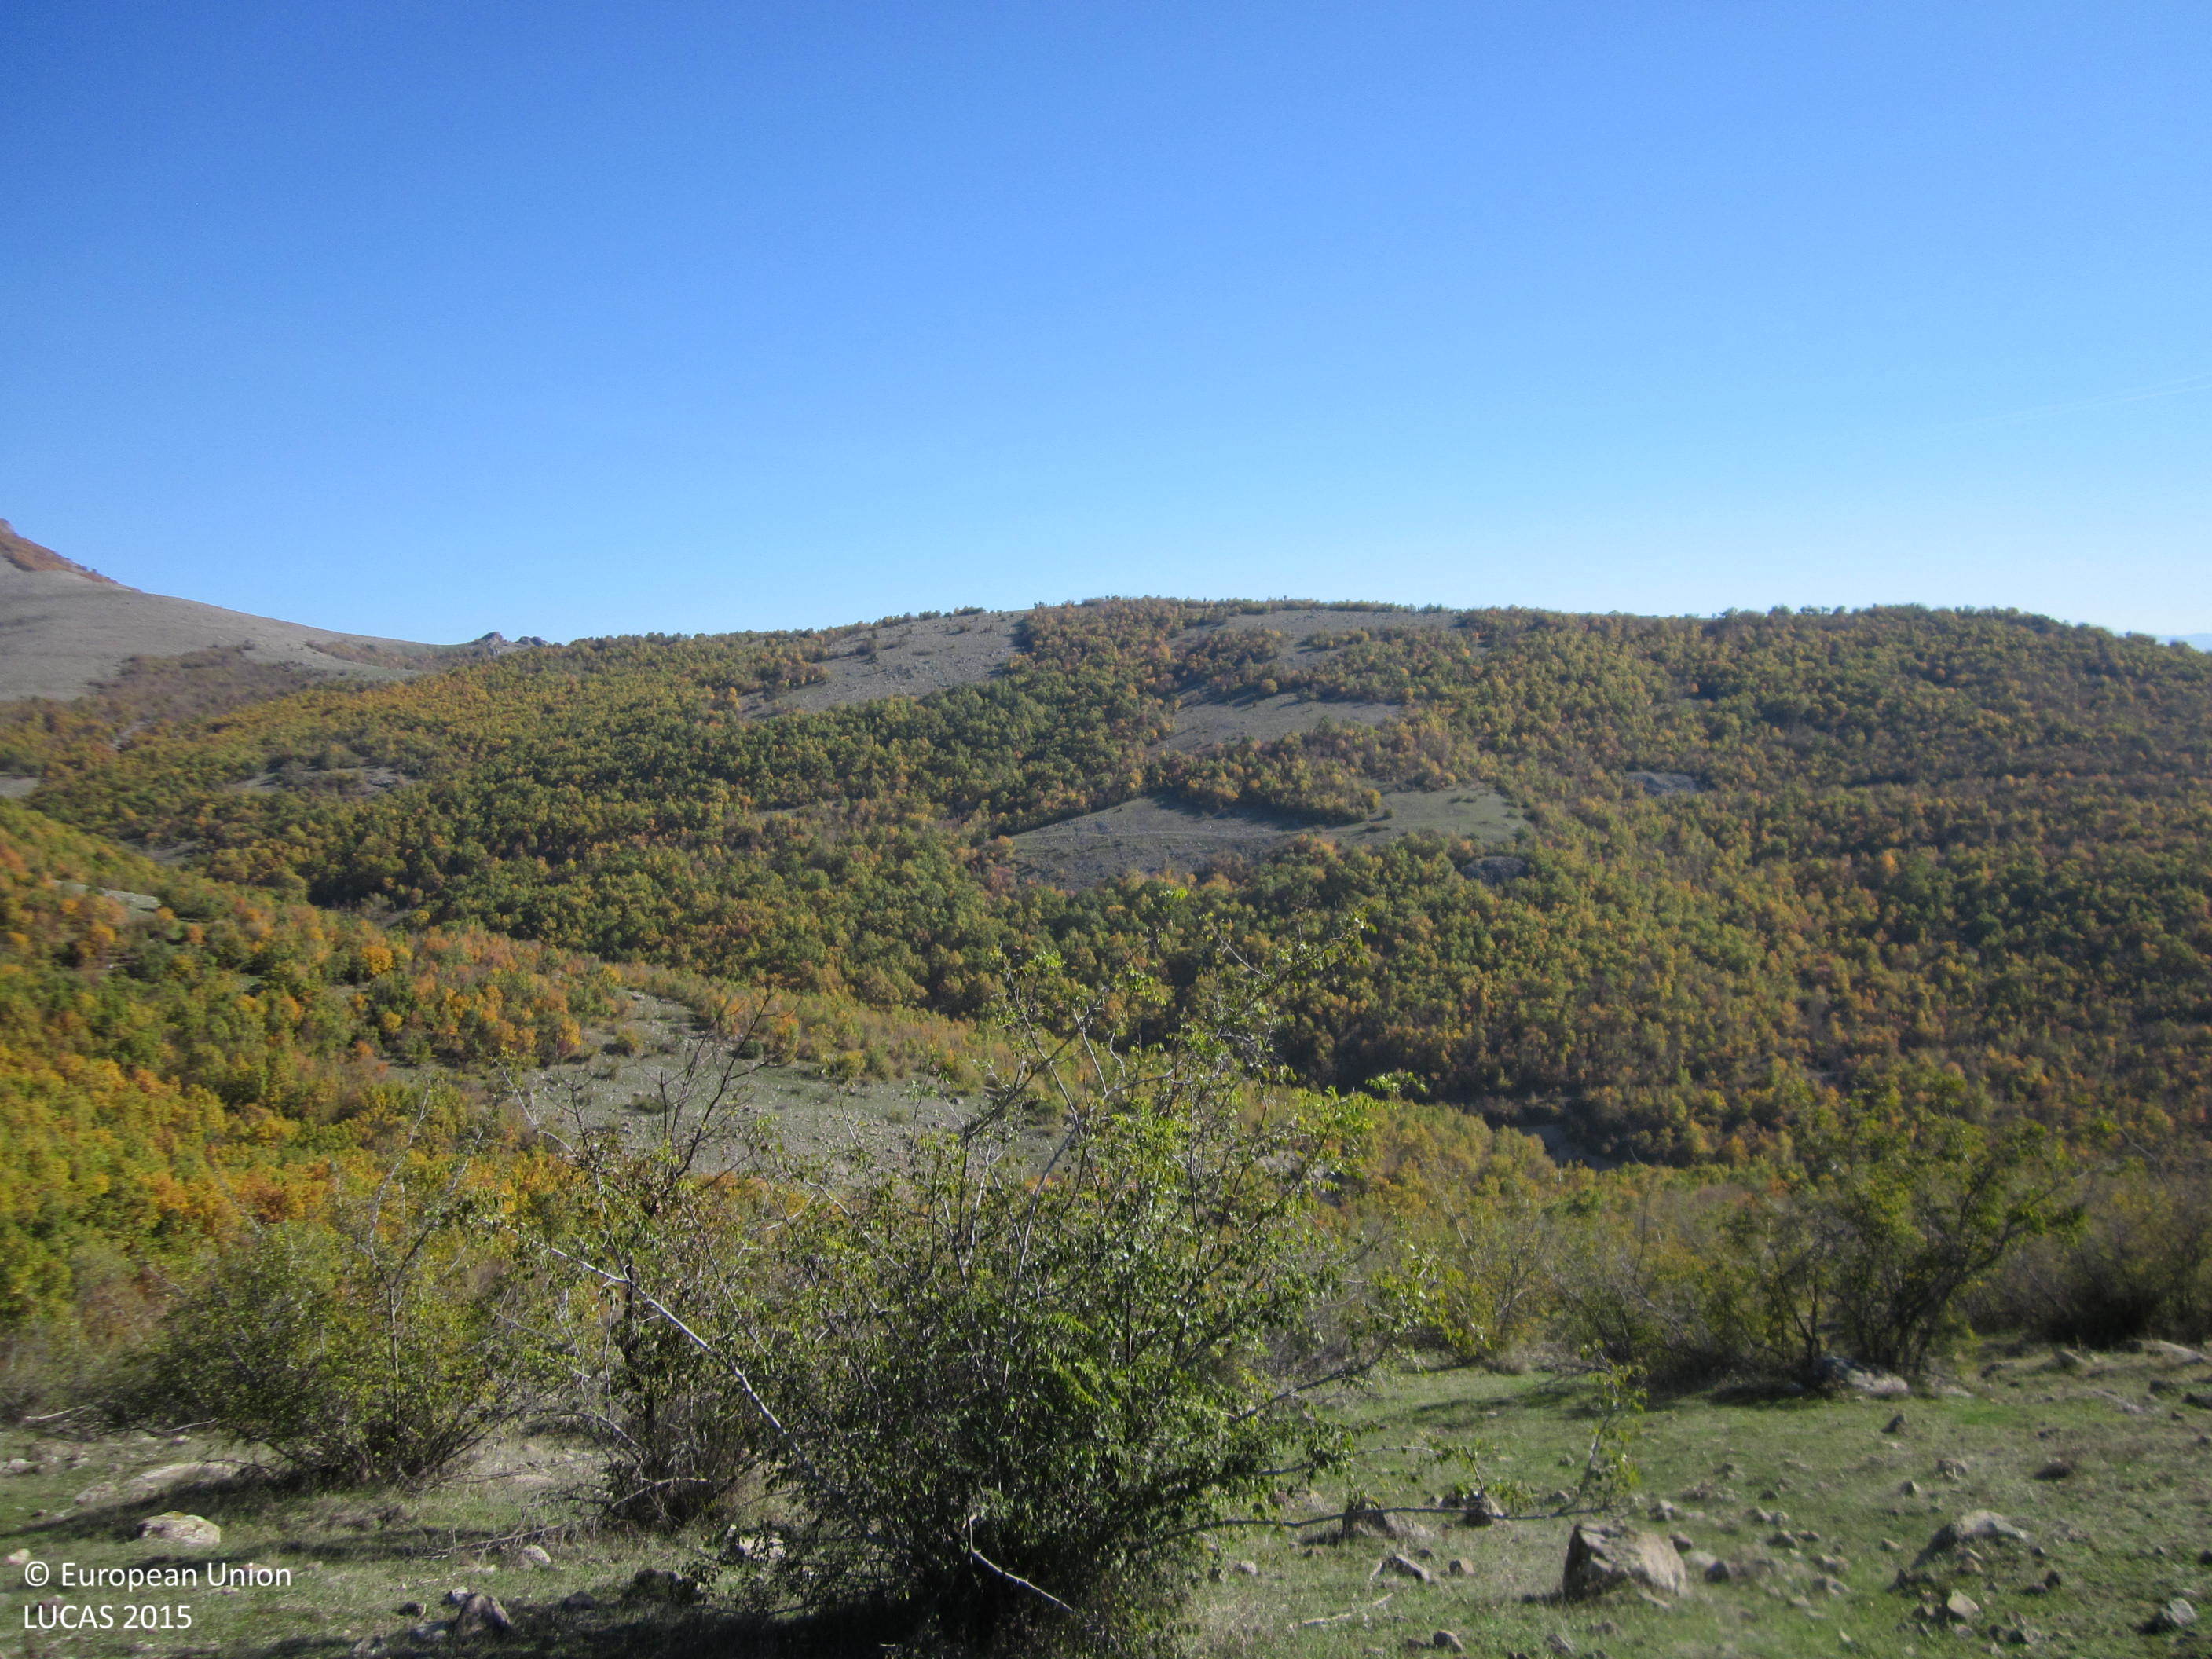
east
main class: Grassland
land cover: Grassland with sparse tree/shrub cover
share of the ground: > 75 %
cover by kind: herbaceous plants 70 %, unconsolidated bare surface 20 %, broadleaved forest trees 5 %, shrubs 5 %
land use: Semi-natural and natural areas not in use
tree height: < 5 m
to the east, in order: Grassland with sparse tree/shrub cover; Shrubland without tree cover; Broadleaved woodland
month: November
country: BG
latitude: 41.4739
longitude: 25.7123
